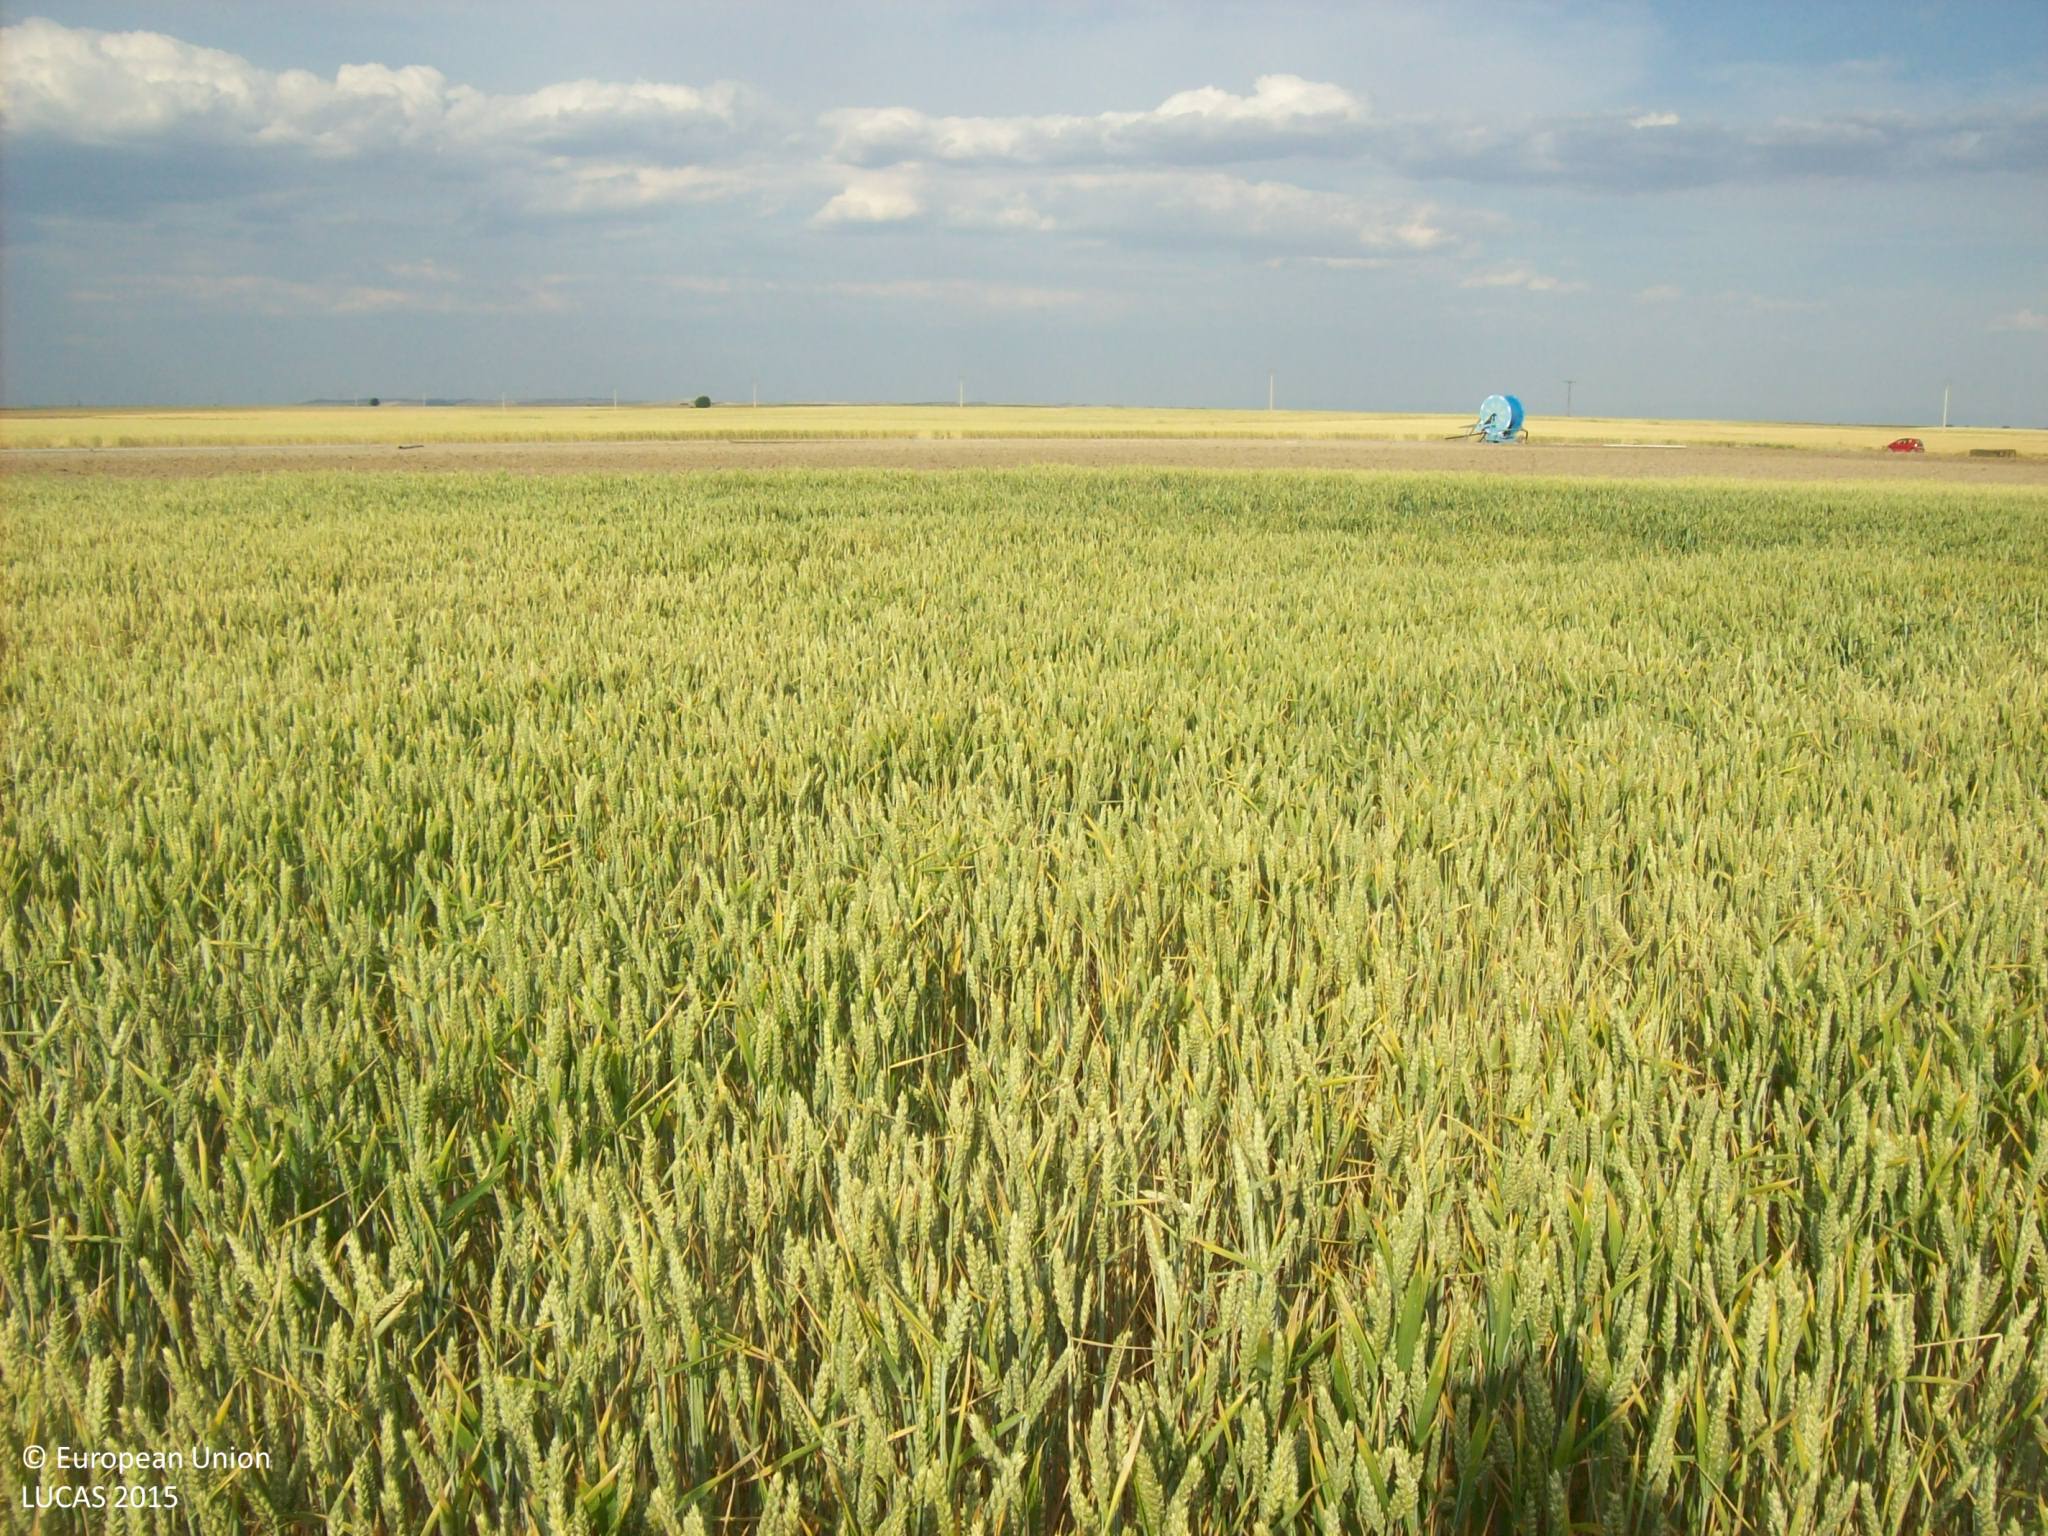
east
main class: Cropland
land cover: Common wheat
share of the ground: > 75 %
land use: Agriculture (excluding fallow land and kitchen gardens)
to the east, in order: Common wheat; Other bare soil; Common wheat
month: June
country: ES
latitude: 41.0459
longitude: -5.0448
